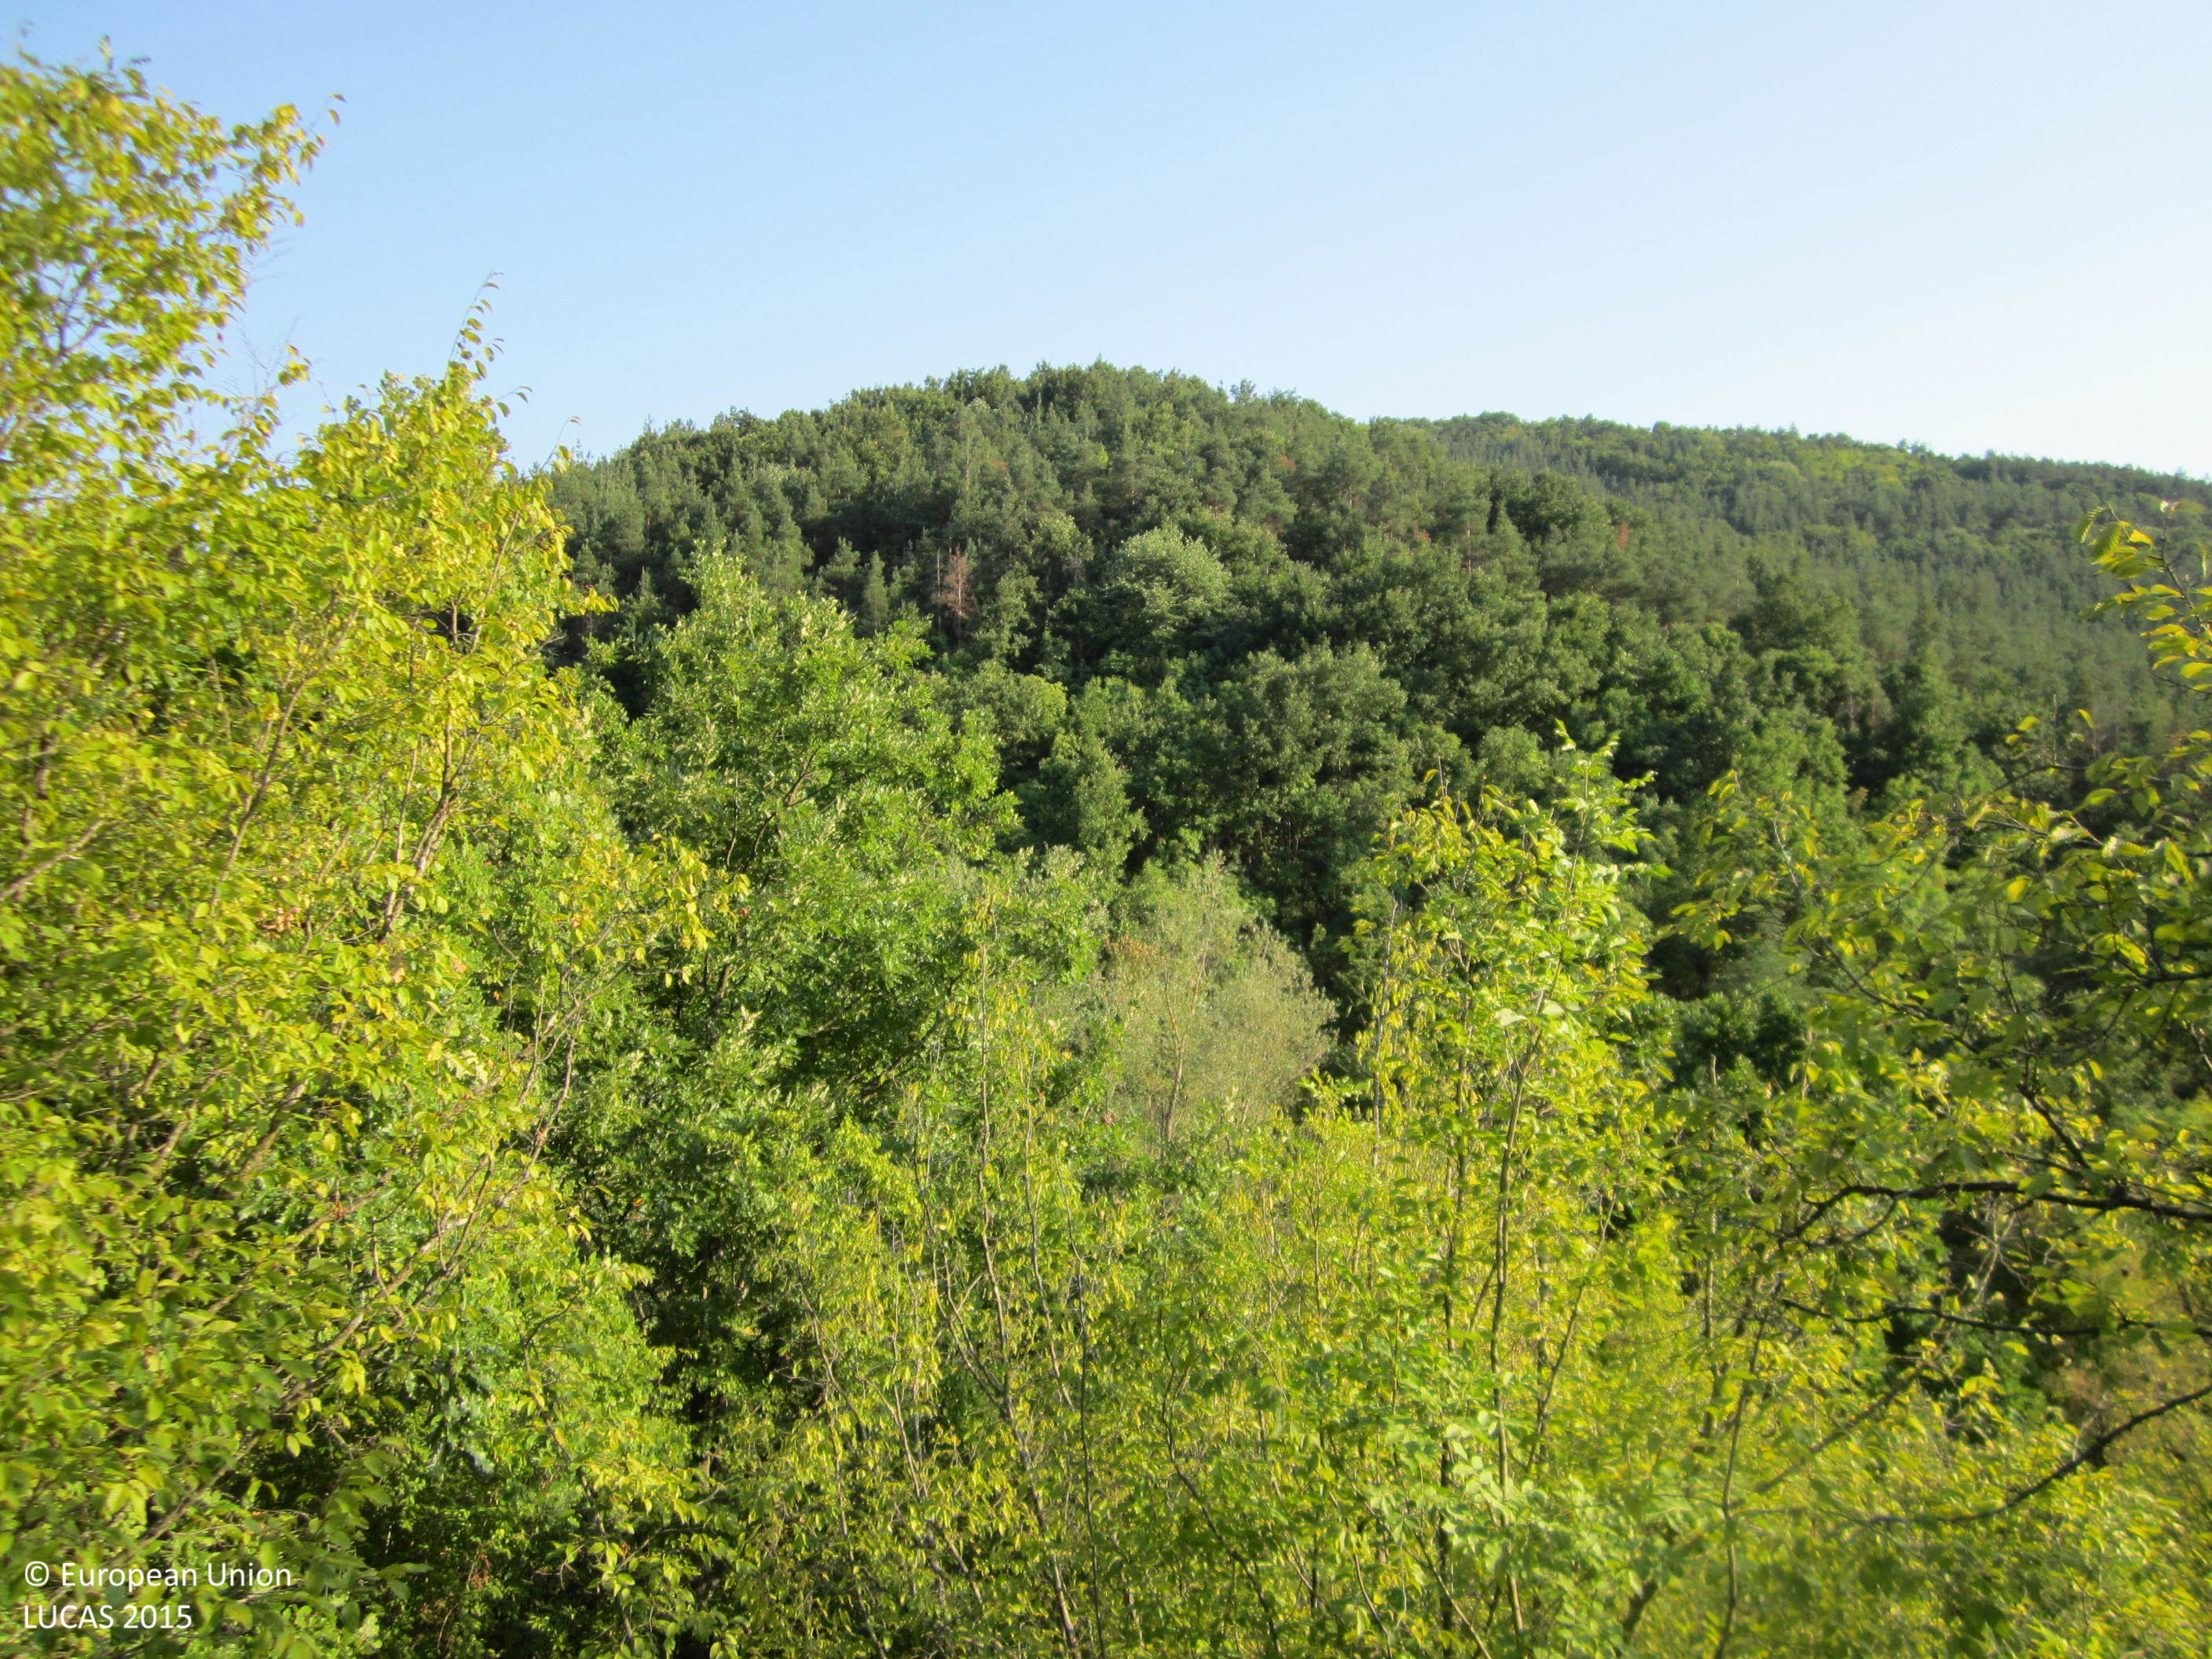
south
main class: Woodland
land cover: Broadleaved woodland
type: mesophytic deciduous forest
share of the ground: > 75 %
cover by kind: broadleaved forest trees 100 %
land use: Forestry
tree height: > 5 m
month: September
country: BG
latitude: 42.9011
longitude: 27.1999
